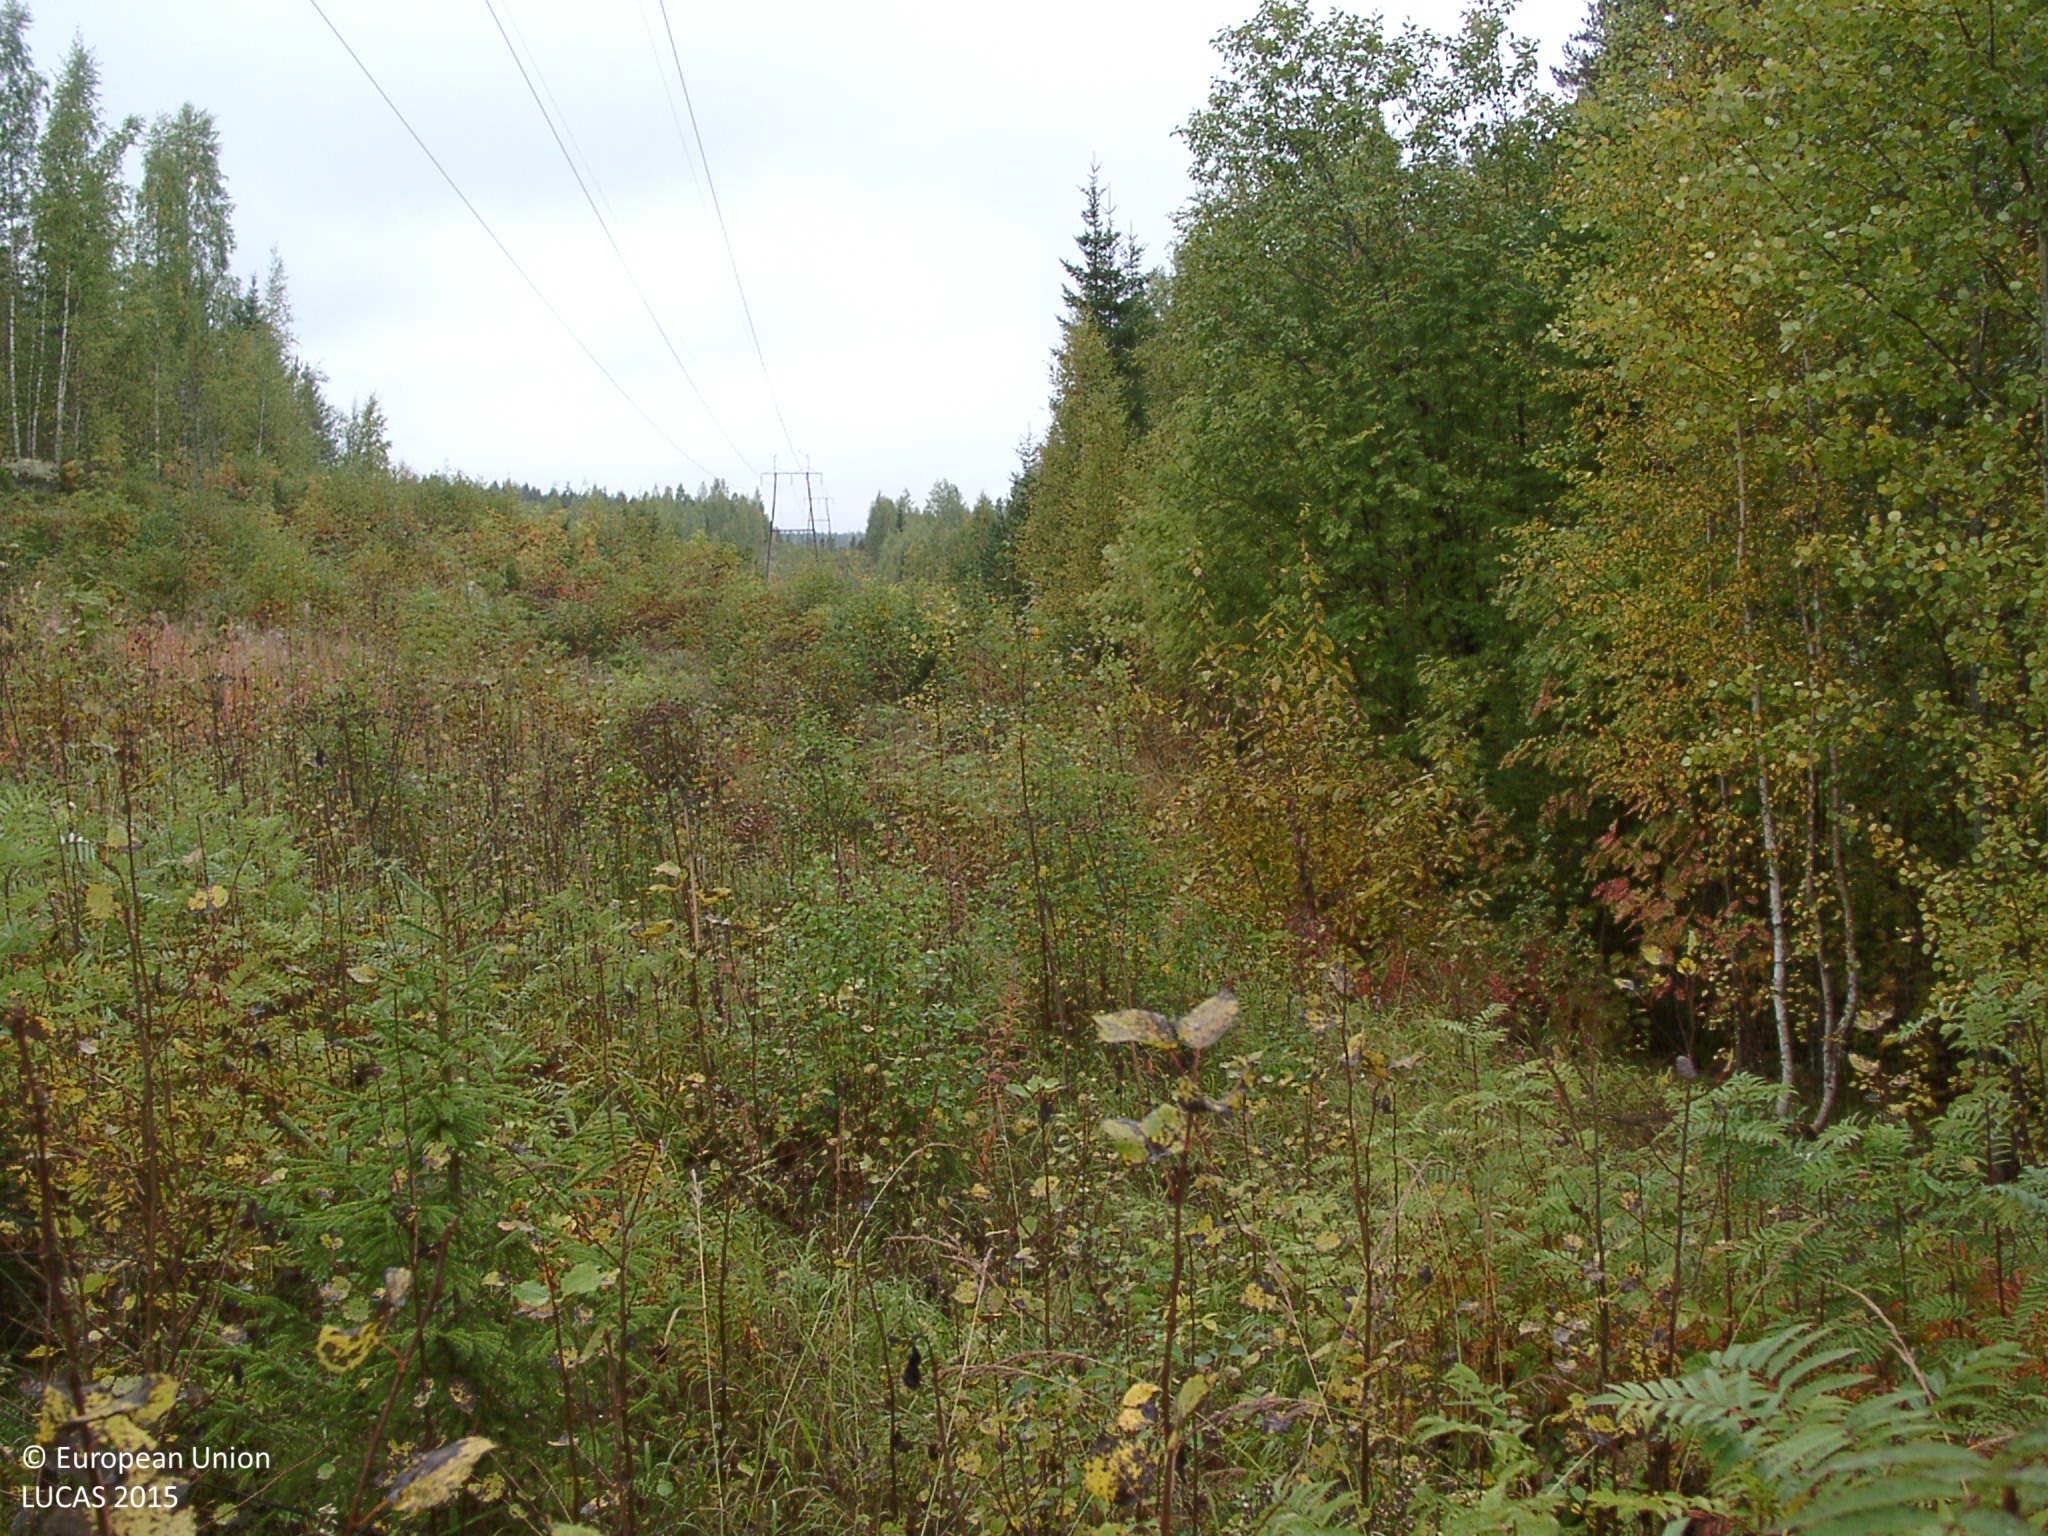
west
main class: Woodland
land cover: Broadleaved woodland
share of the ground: 25 - 50 %
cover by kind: herbaceous plants 60 %, broadleaved forest trees 35 %, shrubs 5 %
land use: Electricity, gas and thermal power distribution
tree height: < 5 m
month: September
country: FI
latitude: 62.5861
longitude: 25.5907
